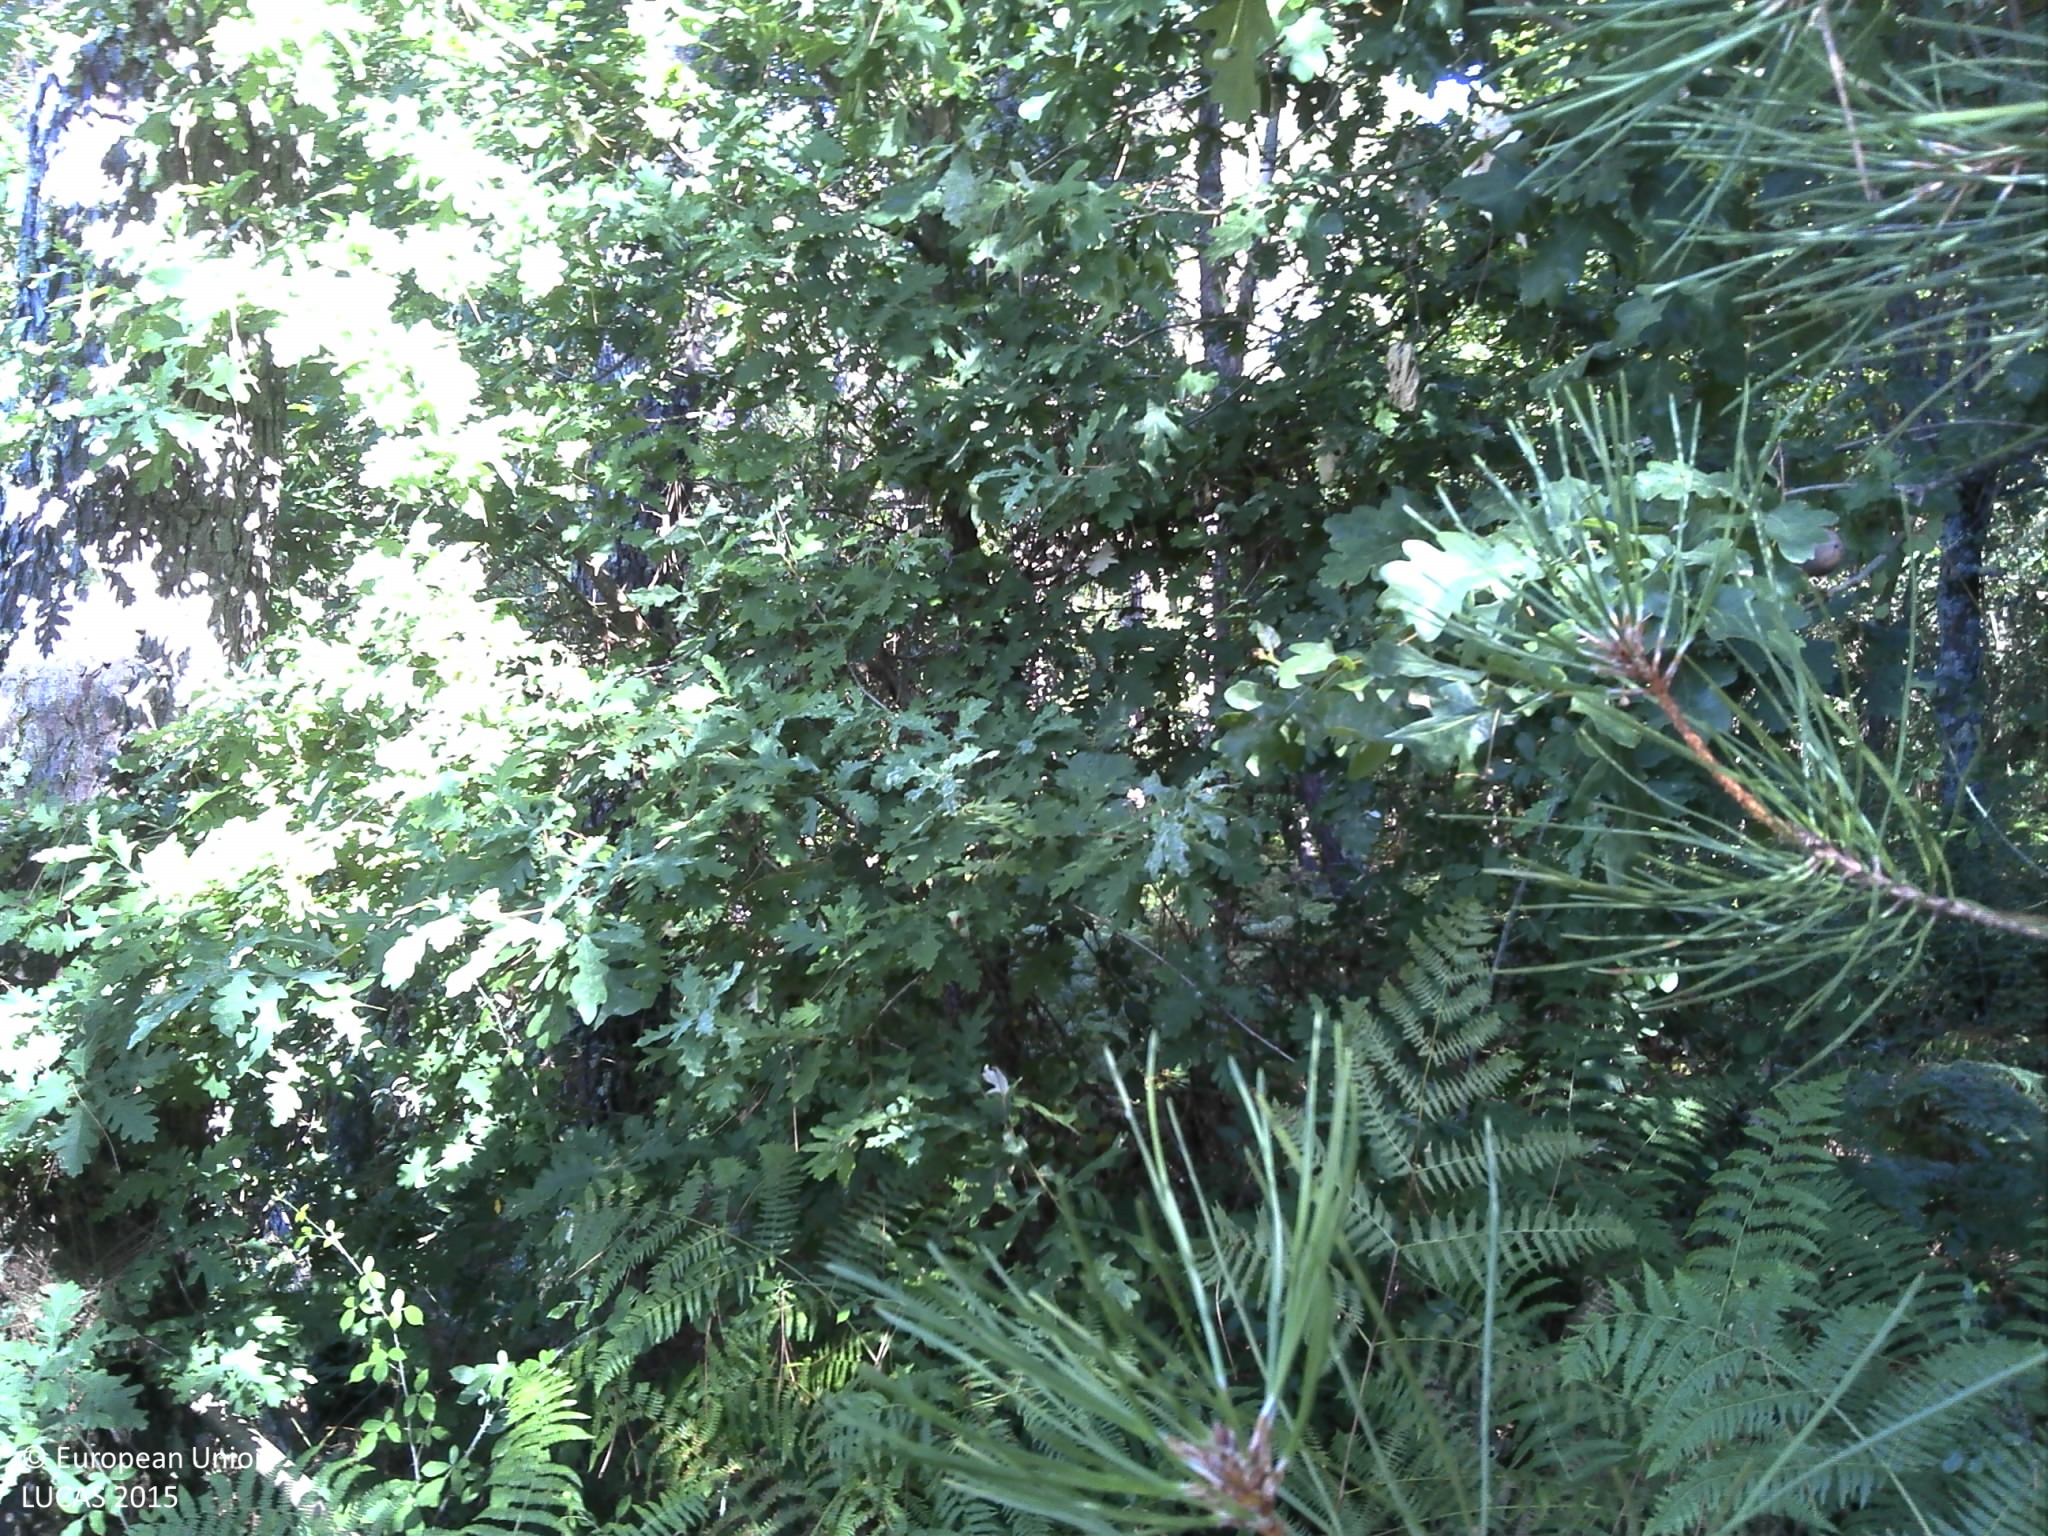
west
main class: Woodland
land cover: Pine dominated mixed woodland
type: coniferous forest of the mediterranean region
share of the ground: 10 - 25 %
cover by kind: shrubs 80 %, coniferous forest trees 15 %, broadleaved forest trees 5 %
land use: Forestry
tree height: > 5 m
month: July
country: PT
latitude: 40.8001
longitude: -7.8205
